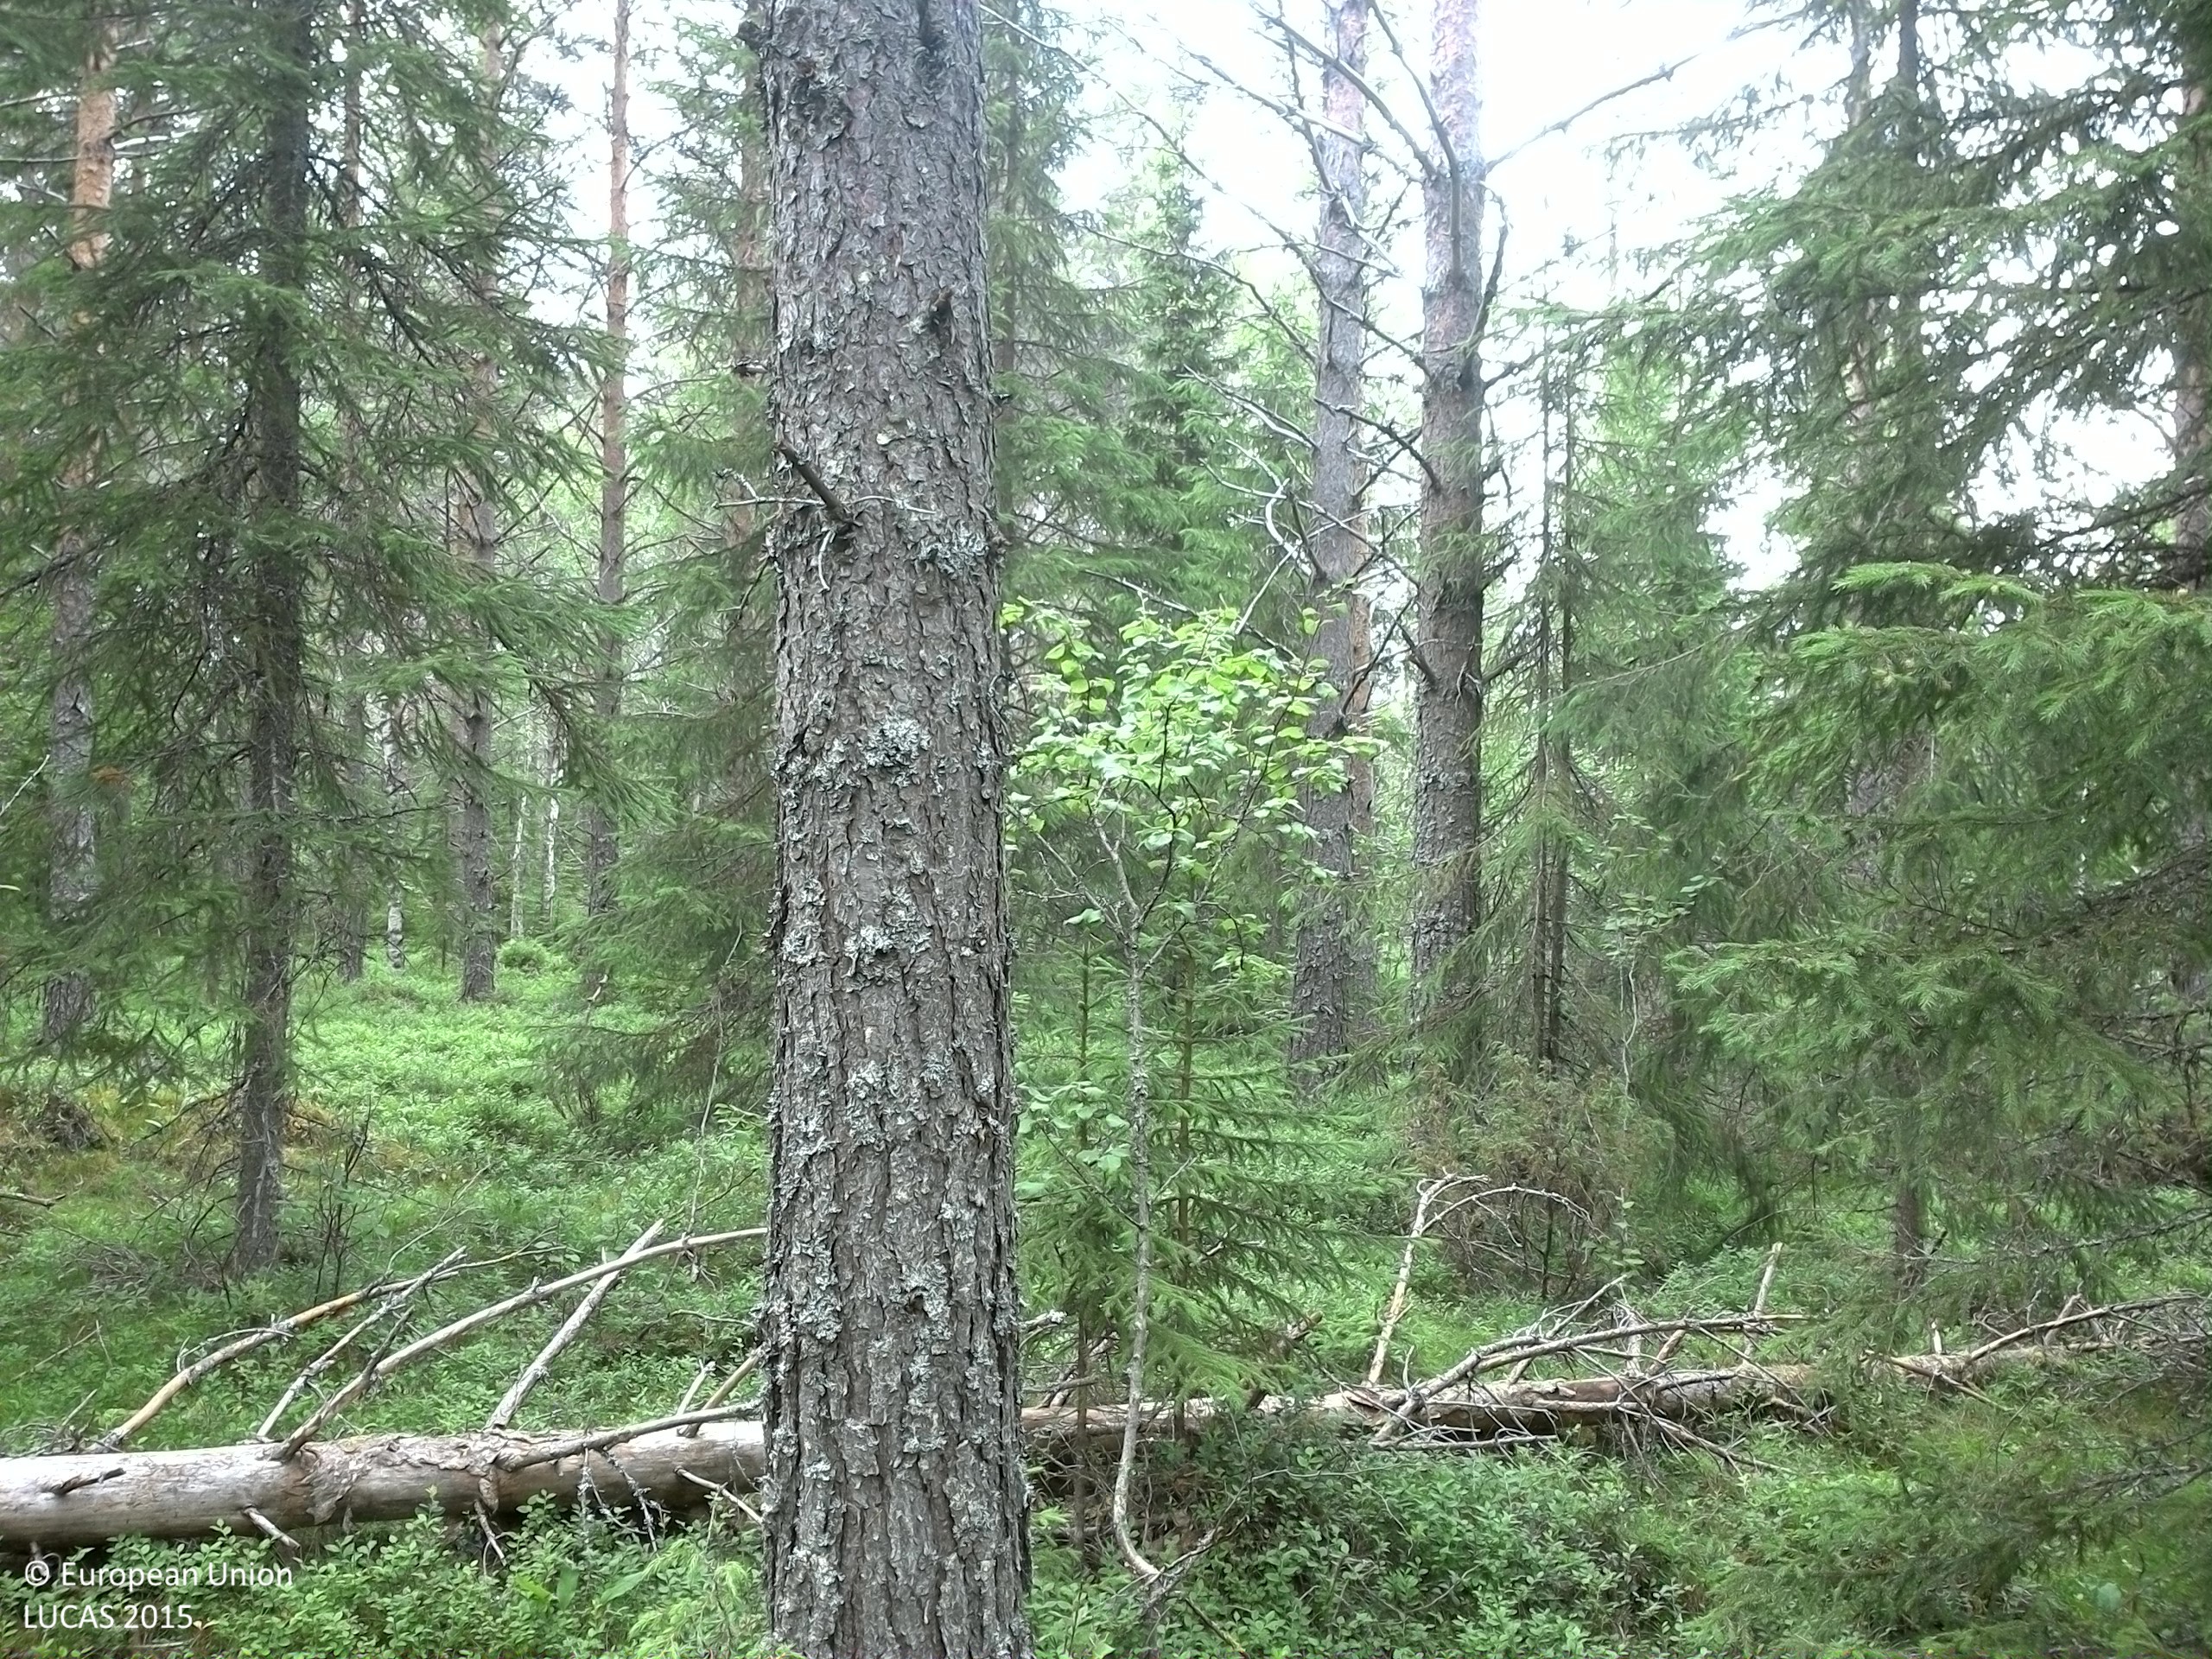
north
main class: Woodland
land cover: Pine dominated coniferous woodland
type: boreal forest
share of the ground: 50 - 75 %
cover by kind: coniferous forest trees 50 %, shrubs 30 %, lichens and mosses 15 %, herbaceous plants 5 %
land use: Forestry
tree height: > 5 m
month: July
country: SE
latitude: 62.7696
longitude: 17.1282
